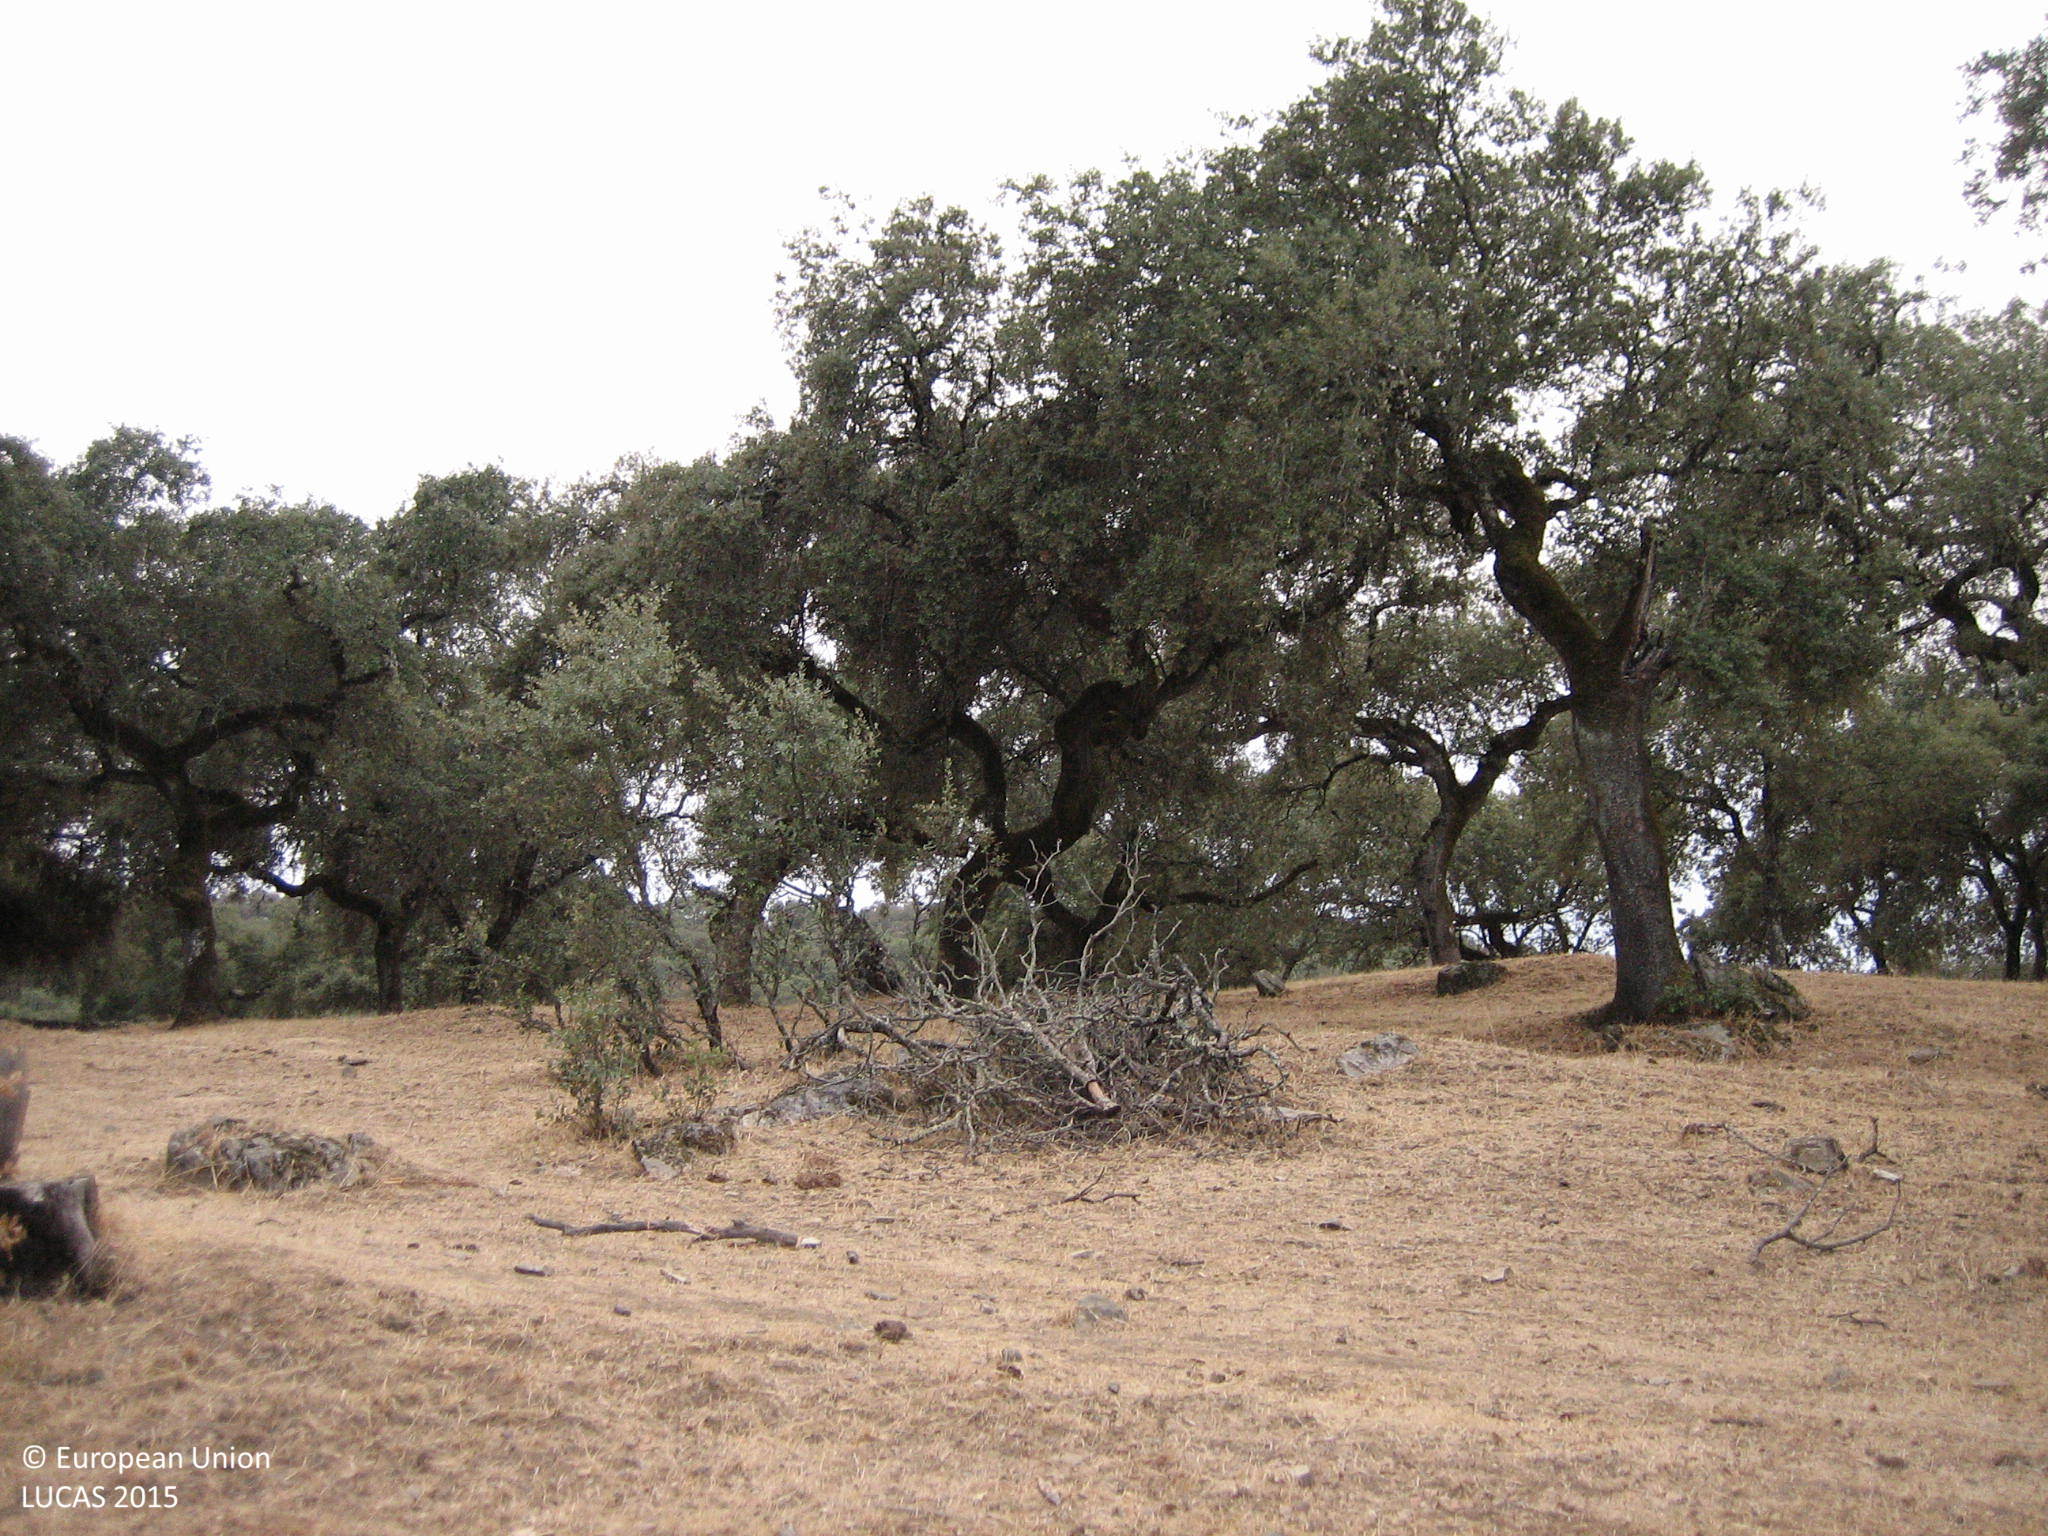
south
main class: Woodland
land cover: Broadleaved woodland
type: broadleaved evergreen forest
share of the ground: 25 - 50 %
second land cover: Grassland without tree/shrub cover
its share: > 75 %
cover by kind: herbaceous plants 55 %, broadleaved forest trees 40 %, shrubs 5 %
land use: Forestry
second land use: Agriculture (excluding fallow land and kitchen gardens)
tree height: > 5 m
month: September
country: ES
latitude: 38.3386
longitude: -6.8409
